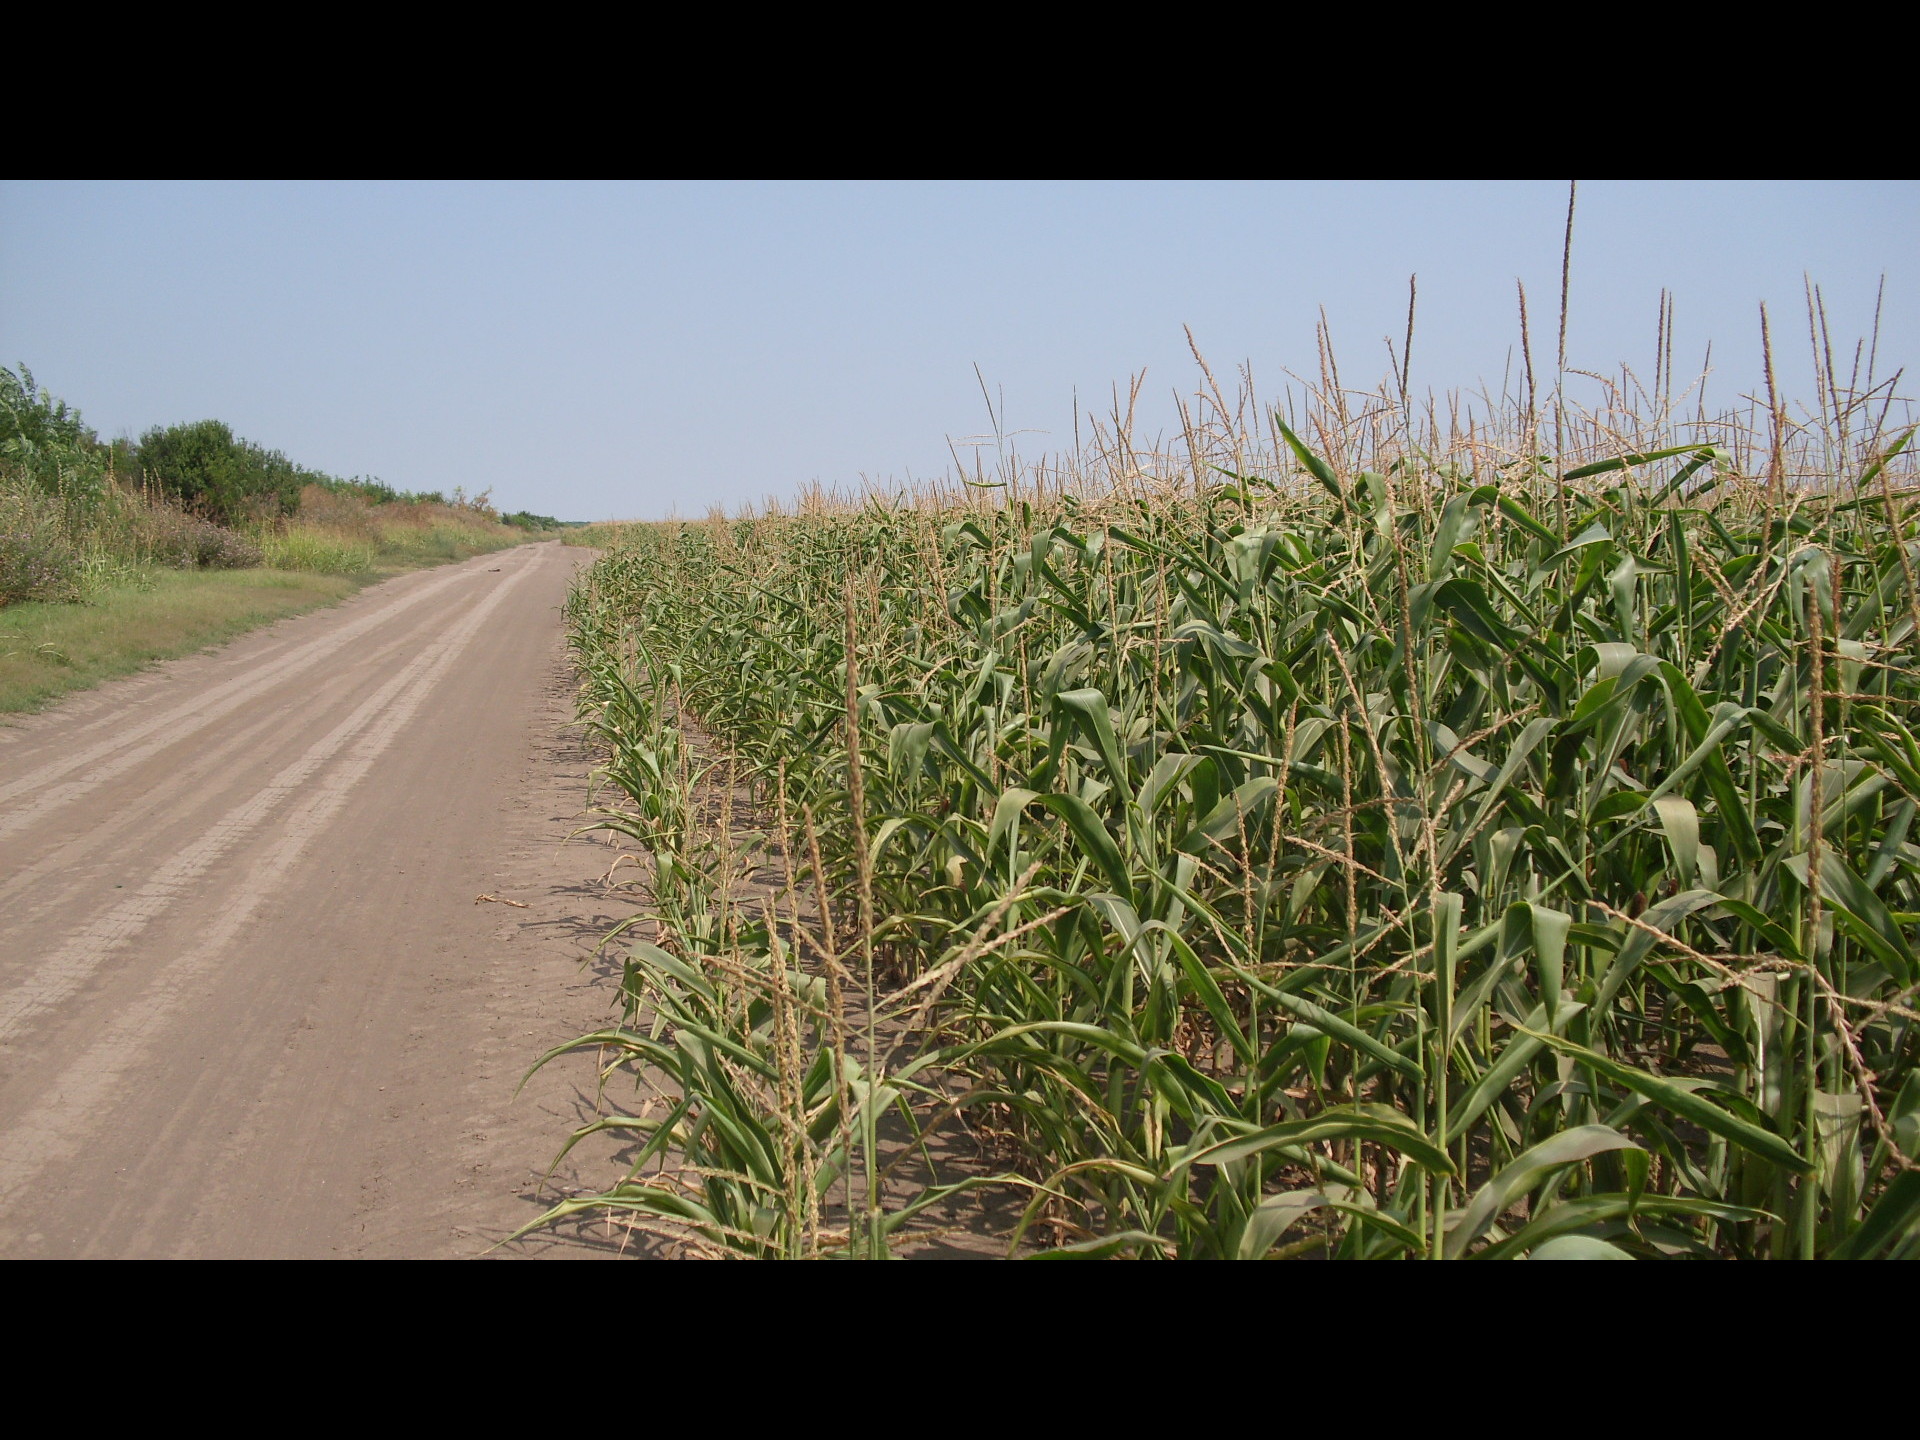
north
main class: Cropland
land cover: Maize
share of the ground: > 75 %
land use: Agriculture (excluding fallow land and kitchen gardens)
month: August
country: BG
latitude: 43.7014
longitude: 23.6363
